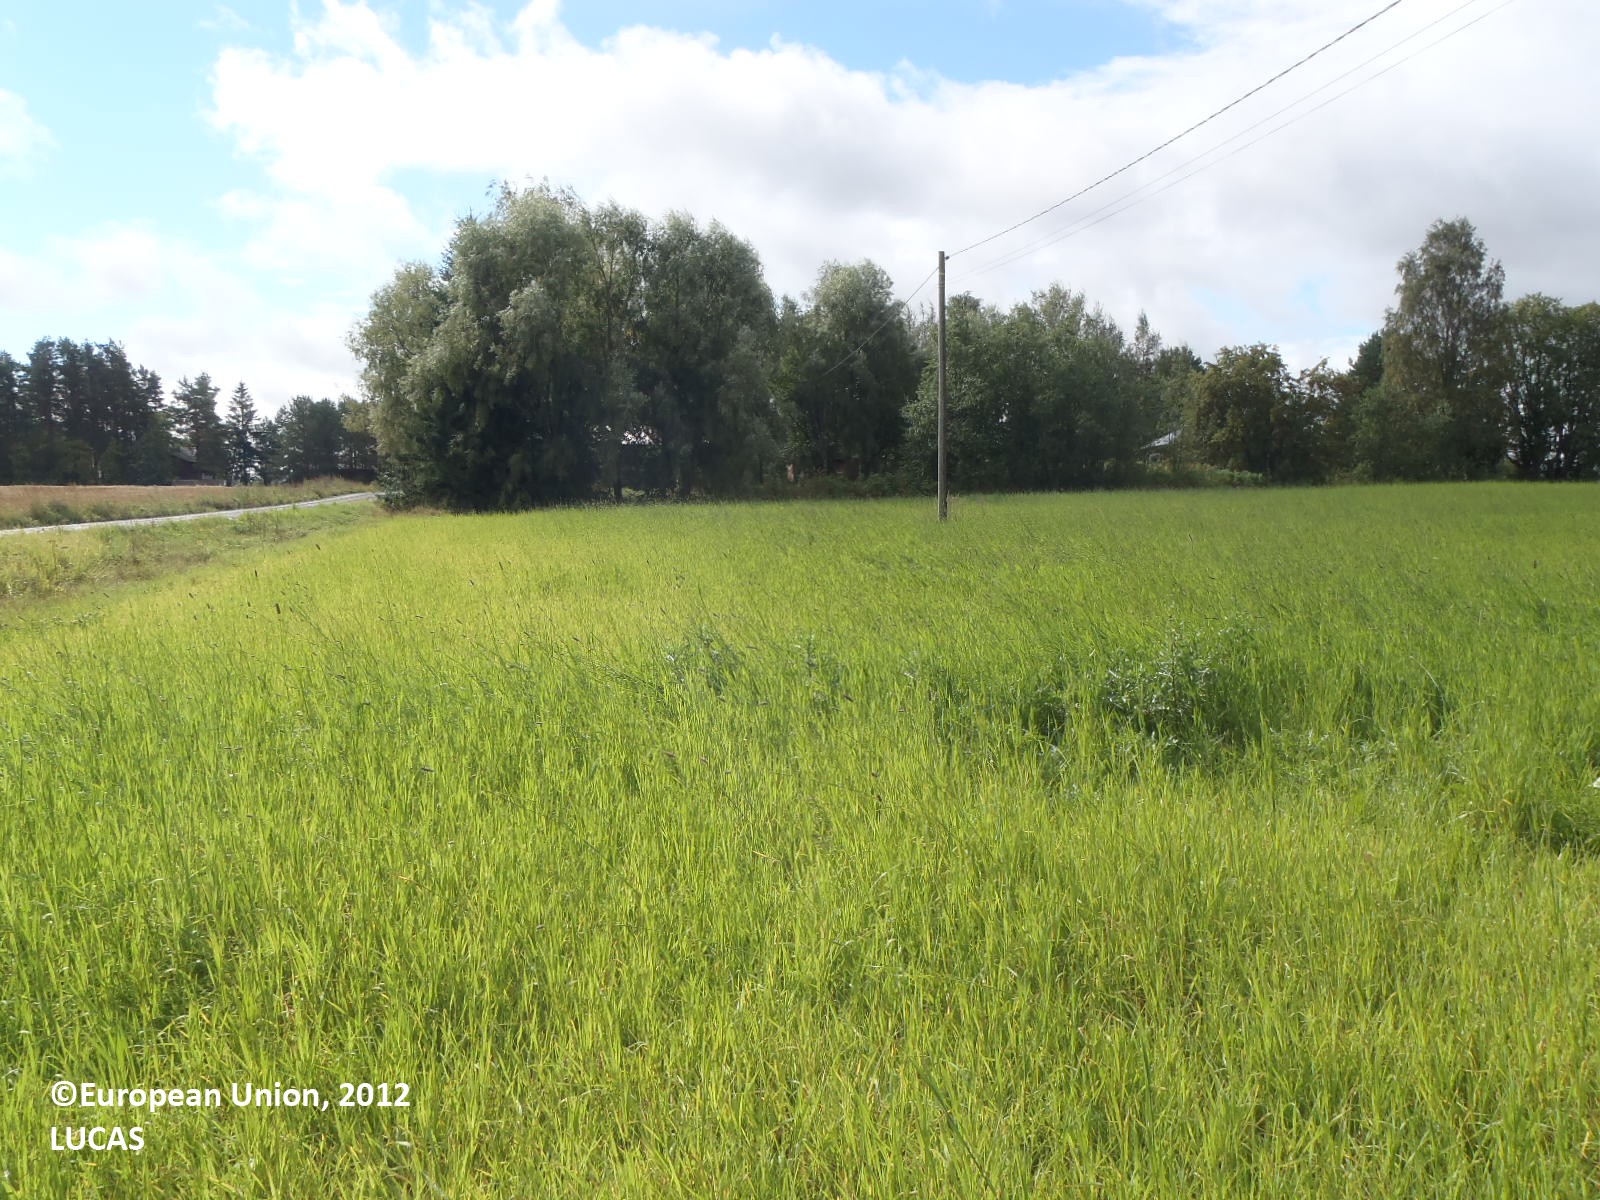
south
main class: Cropland
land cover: Temporary grasslands
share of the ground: > 75 %
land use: Agriculture (excluding fallow land and kitchen gardens)
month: September
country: FI
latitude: 61.0668
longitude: 22.6881
